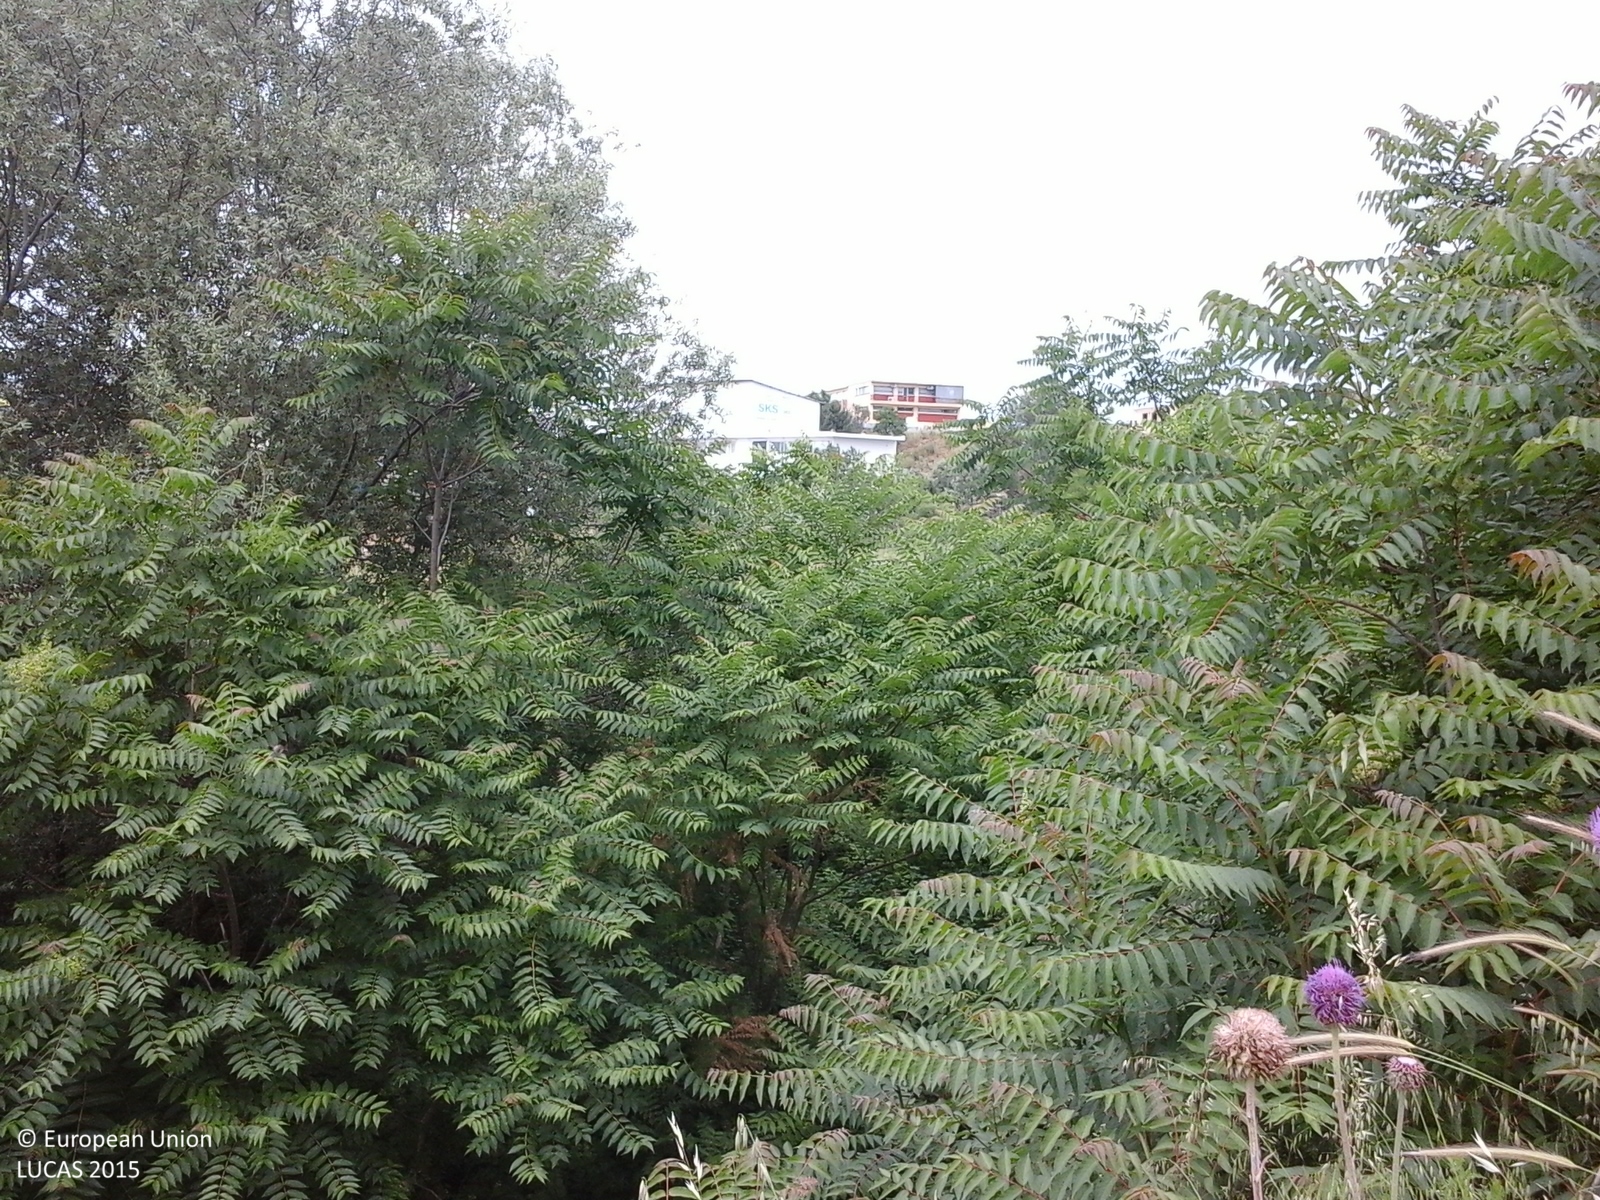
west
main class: Woodland
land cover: Broadleaved woodland
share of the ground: > 75 %
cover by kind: broadleaved forest trees 100 %
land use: Semi-natural and natural areas not in use
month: May
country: GR
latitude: 40.7047
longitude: 22.9445
